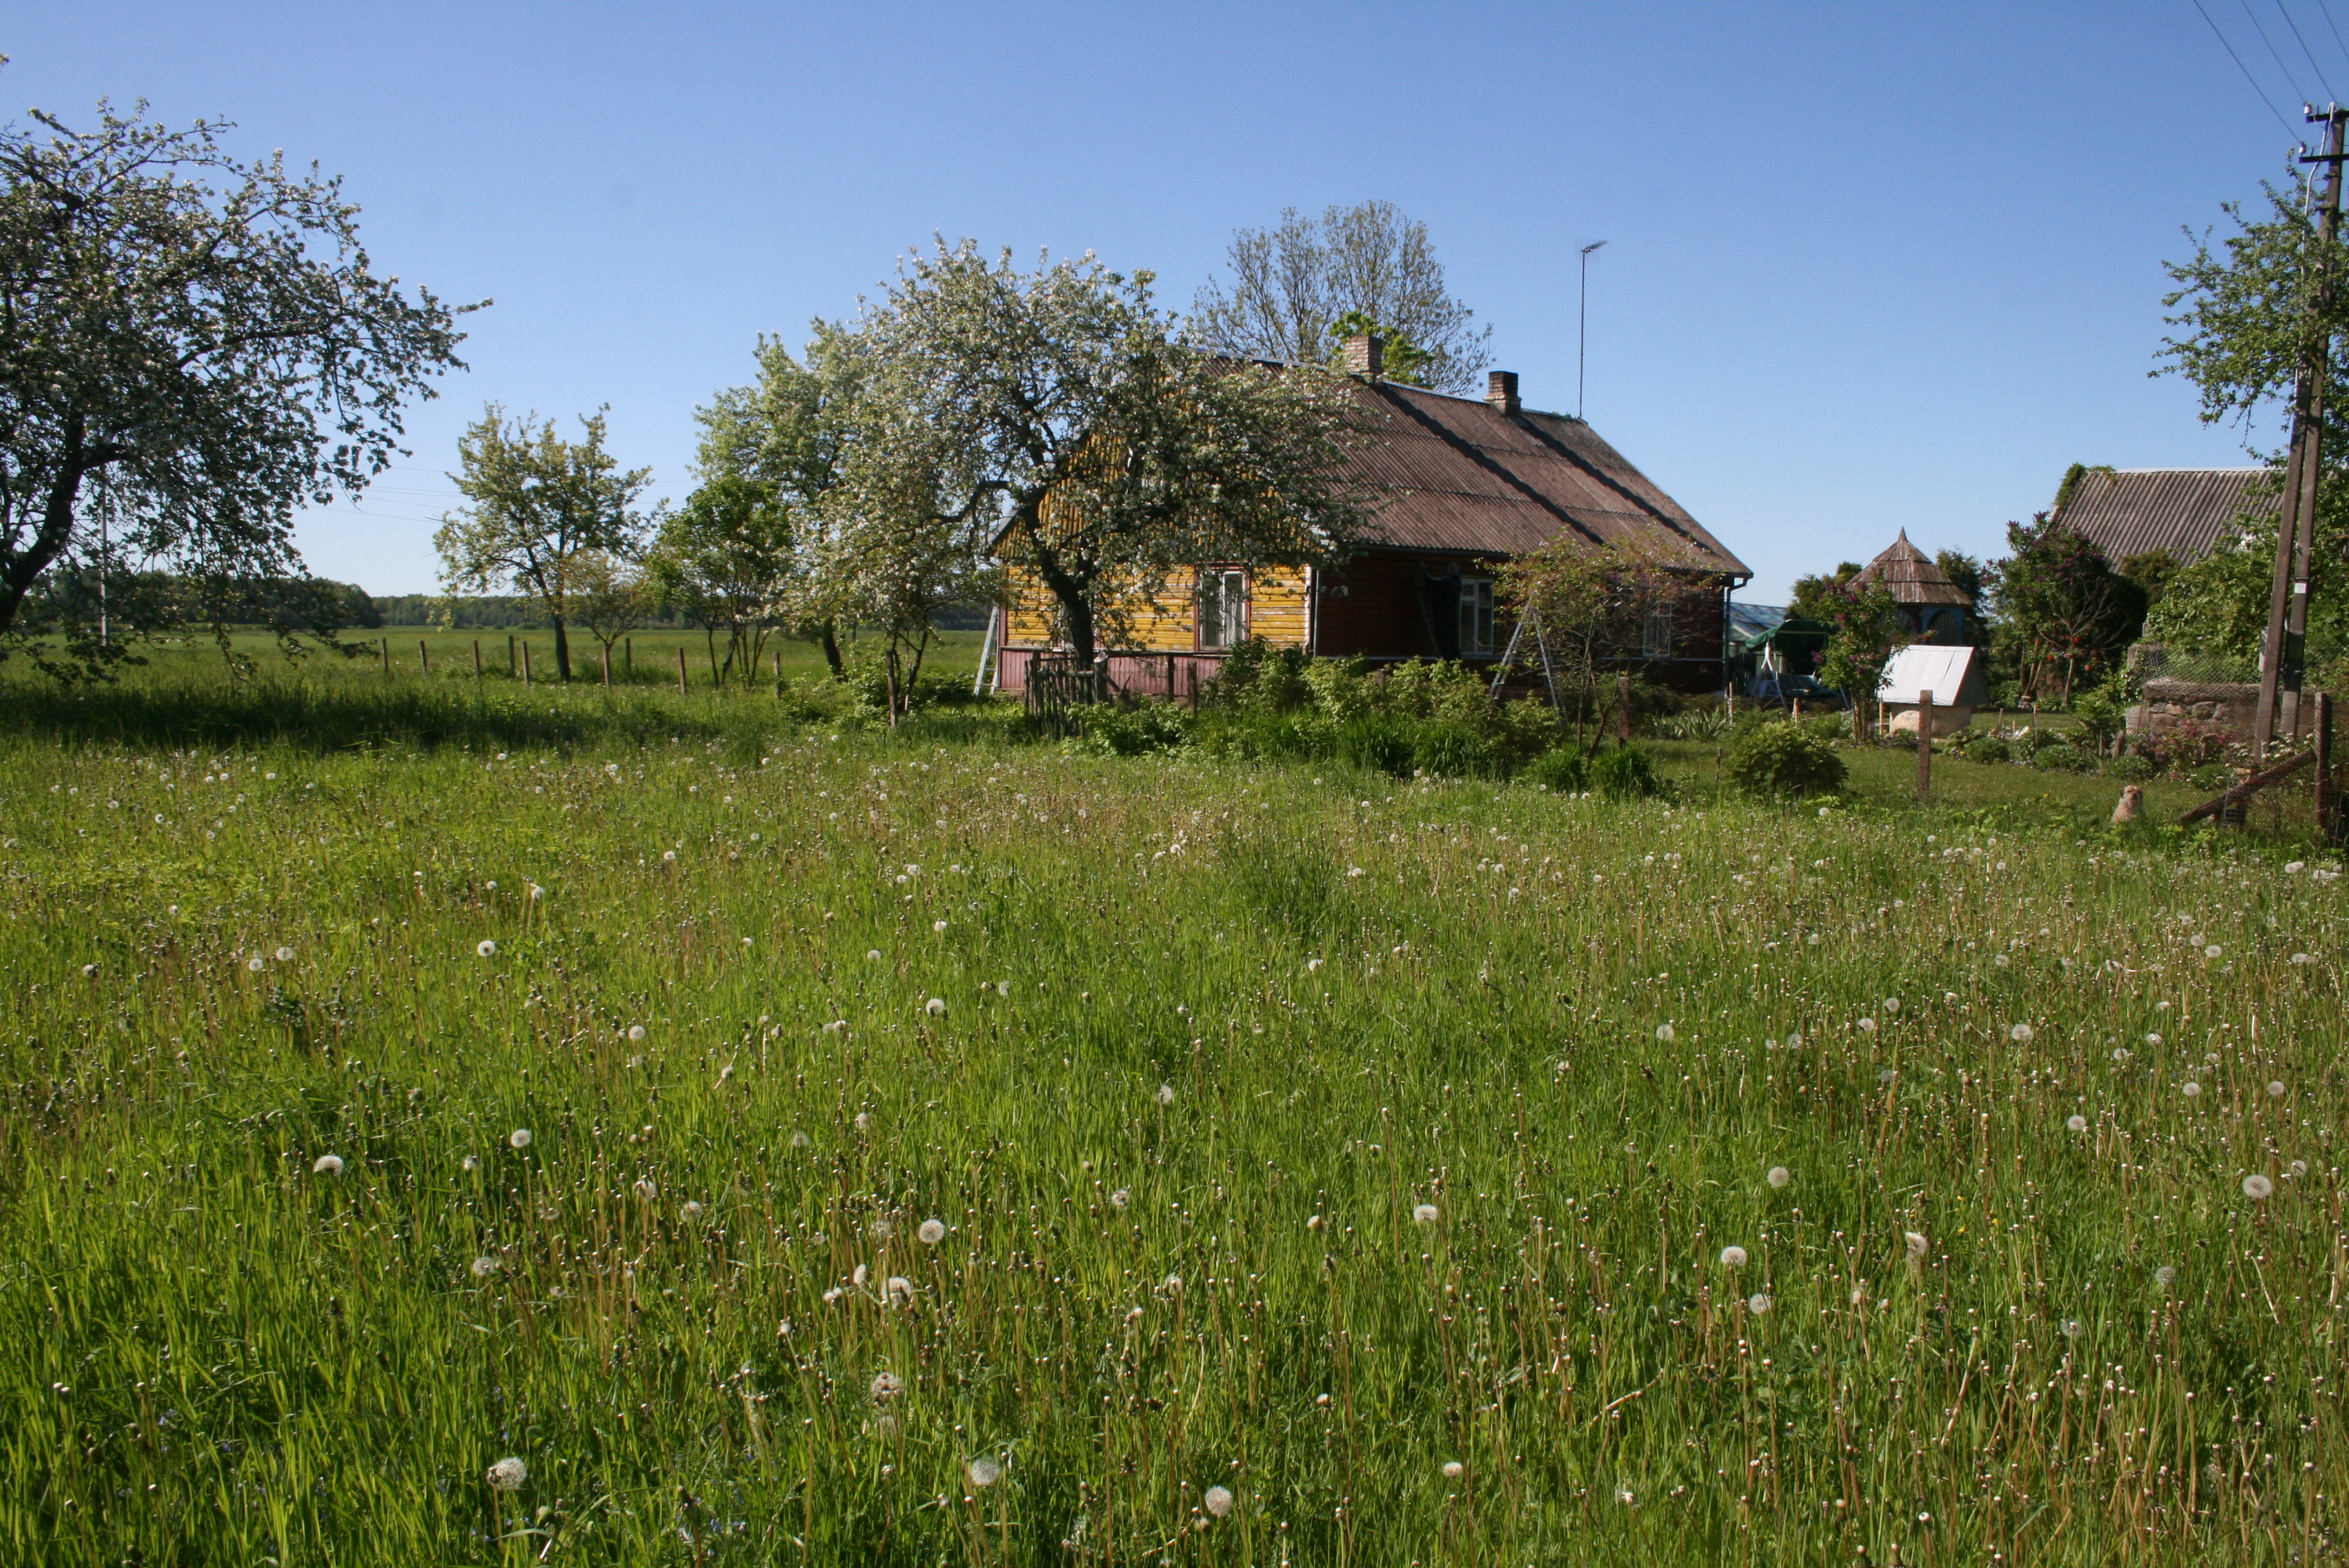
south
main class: Grassland
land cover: Grassland without tree/shrub cover
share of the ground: > 75 %
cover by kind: herbaceous plants 100 %
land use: Agriculture (excluding fallow land and kitchen gardens)
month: May
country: LT
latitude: 56.2485
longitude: 22.3043
